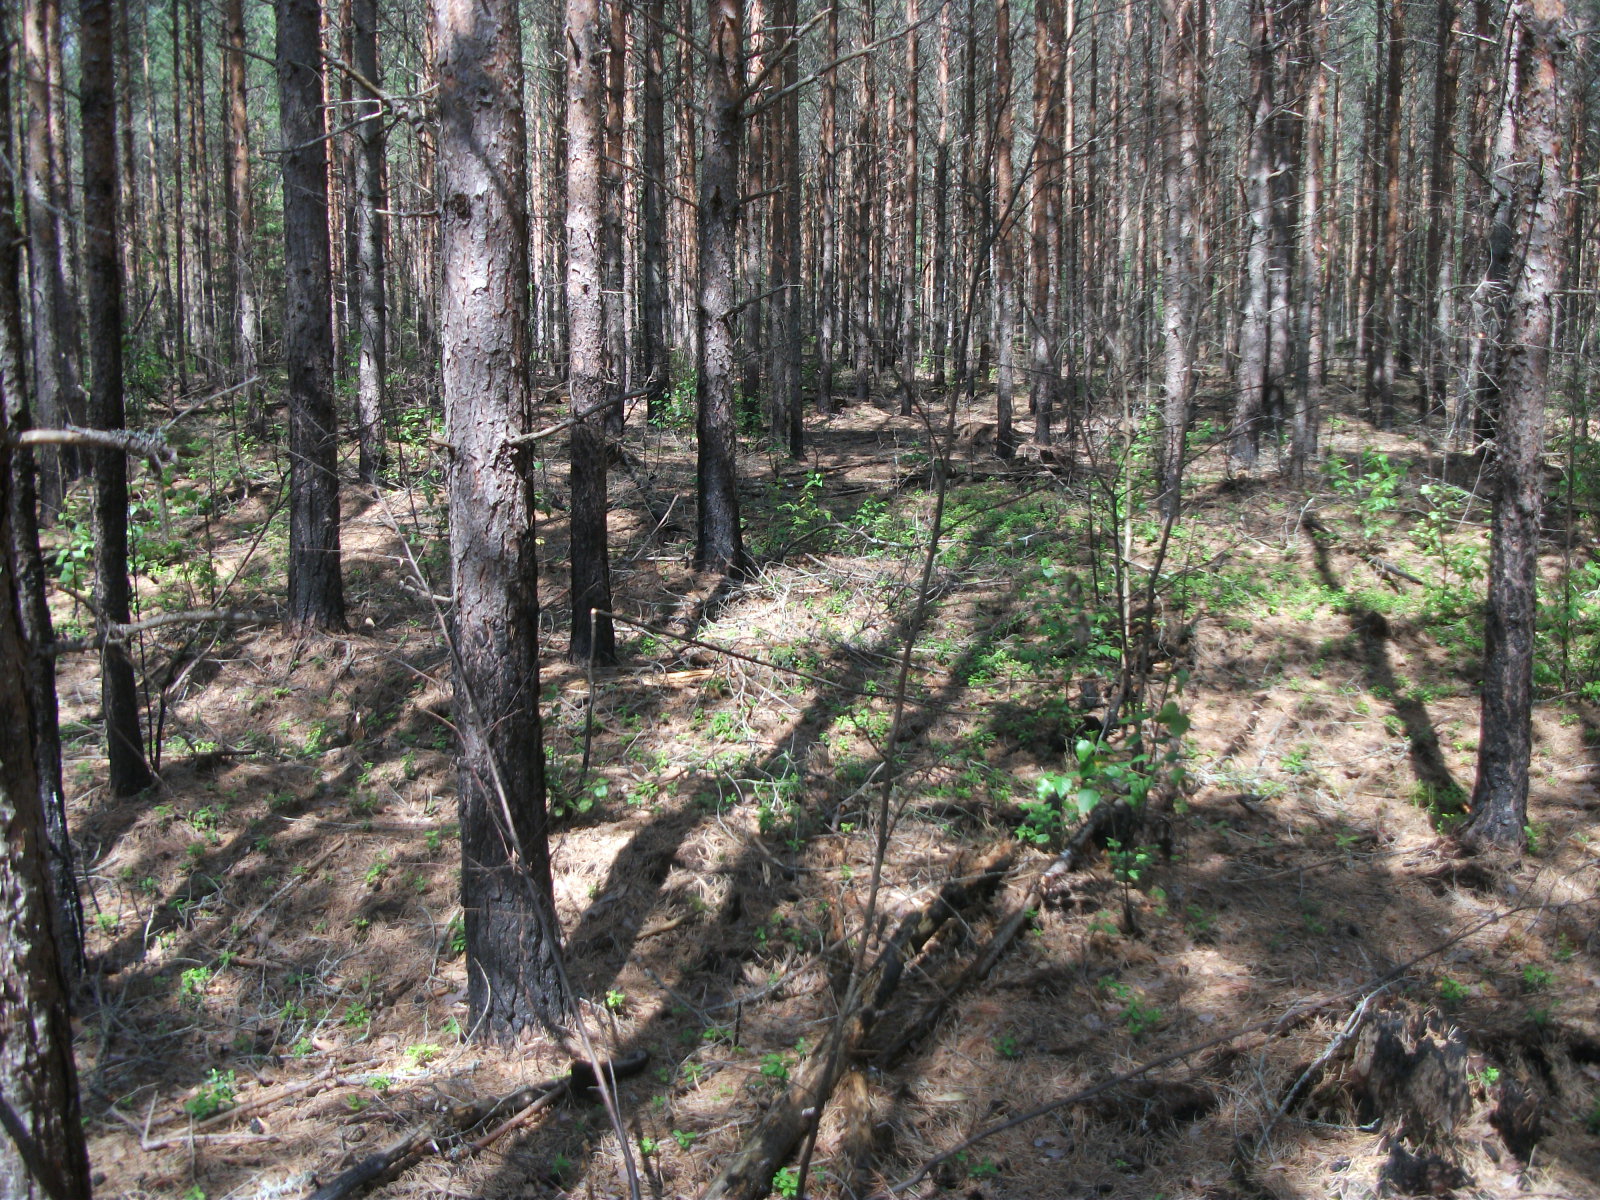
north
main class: Woodland
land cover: Pine dominated coniferous woodland
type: hemiboreal forest and nemoral coniferous forest and mixed broadleaved-coniferous forest
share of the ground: > 75 %
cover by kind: coniferous forest trees 100 %
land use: Forestry
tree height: > 5 m
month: July
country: LV
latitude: 57.0470
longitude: 26.3098
